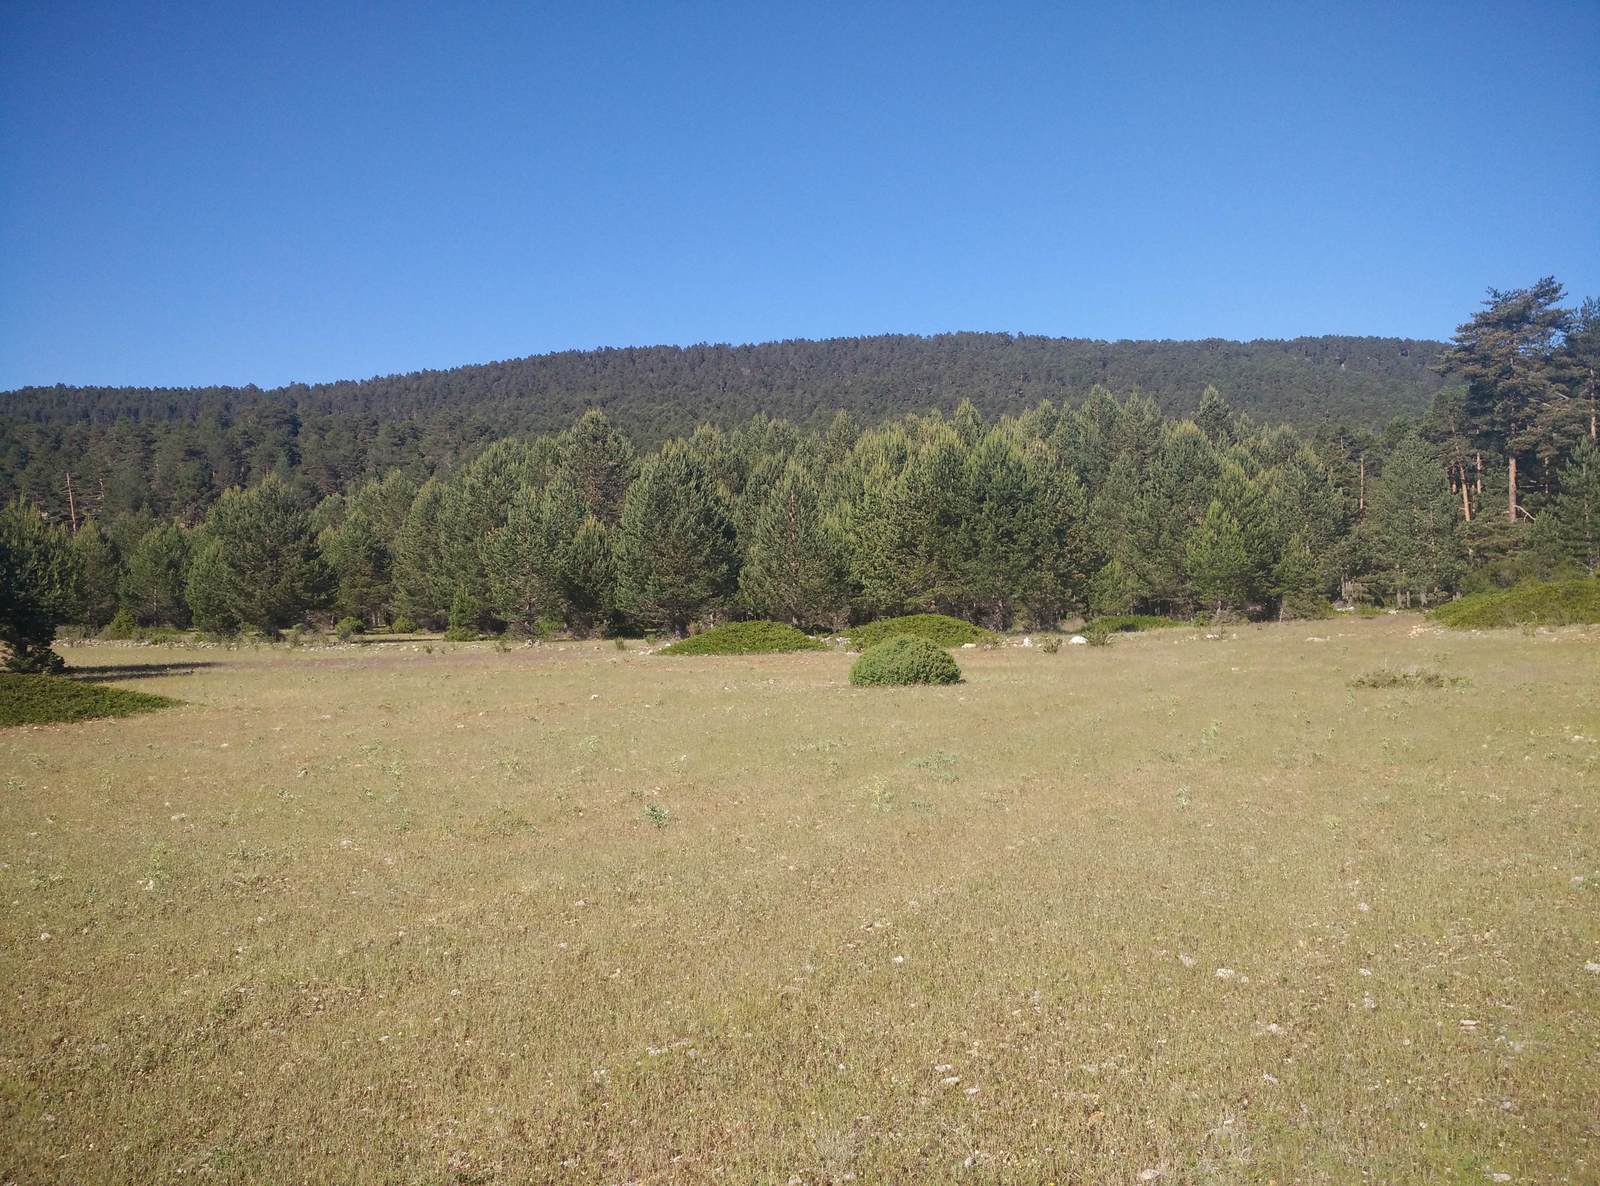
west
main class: Grassland
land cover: Grassland without tree/shrub cover
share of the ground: 50 - 75 %
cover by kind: herbaceous plants 70 %, consolidated bare surface 25 %, unconsolidated bare surface 5 %
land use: Agriculture (excluding fallow land and kitchen gardens)
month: June
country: ES
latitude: 40.3821
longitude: -1.7361
